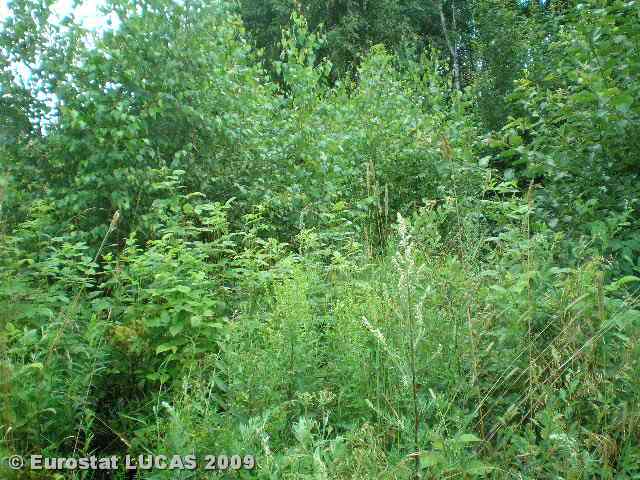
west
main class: Woodland
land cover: Broadleaved woodland
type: hemiboreal forest and nemoral coniferous forest and mixed broadleaved-coniferous forest
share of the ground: > 75 %
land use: Forestry
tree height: > 5 m
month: July
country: LT
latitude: 54.9839
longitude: 25.3264
